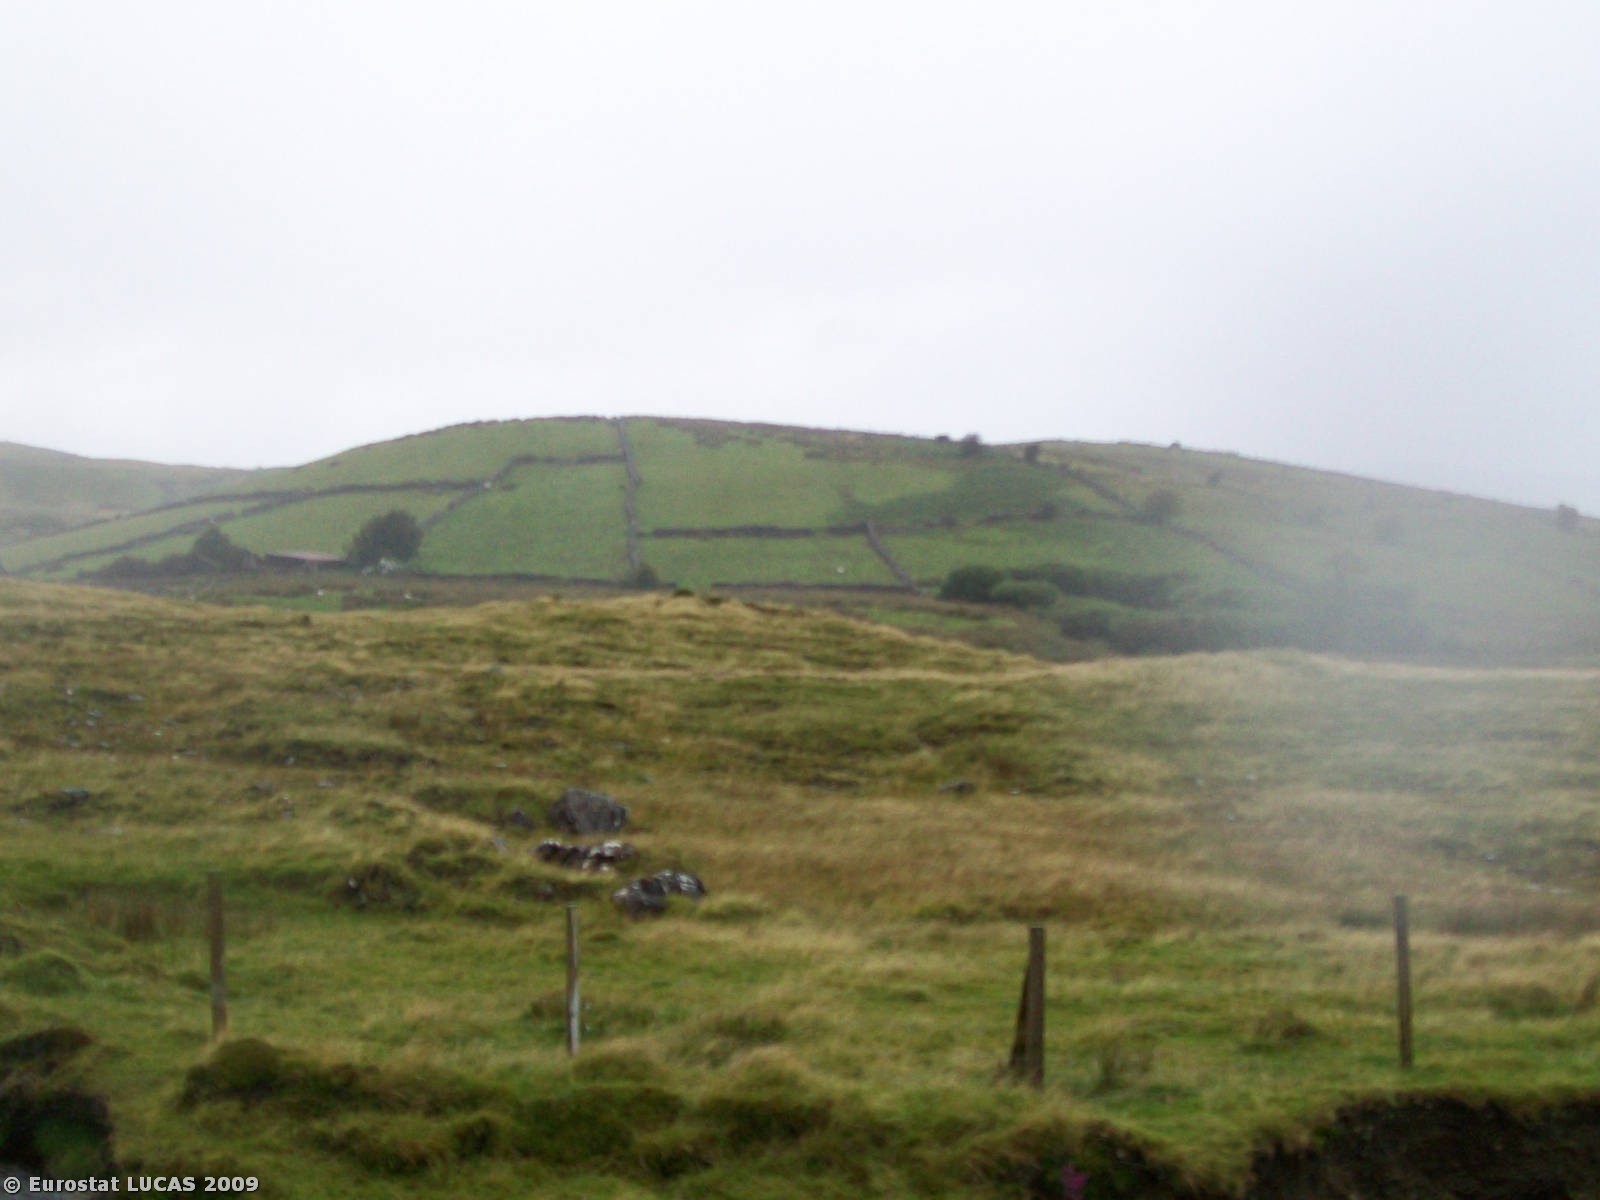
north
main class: Grassland
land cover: Grassland without tree/shrub cover
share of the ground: > 75 %
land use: Agriculture (excluding fallow land and kitchen gardens)
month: July
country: IE
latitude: 53.5405
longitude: -9.4708
